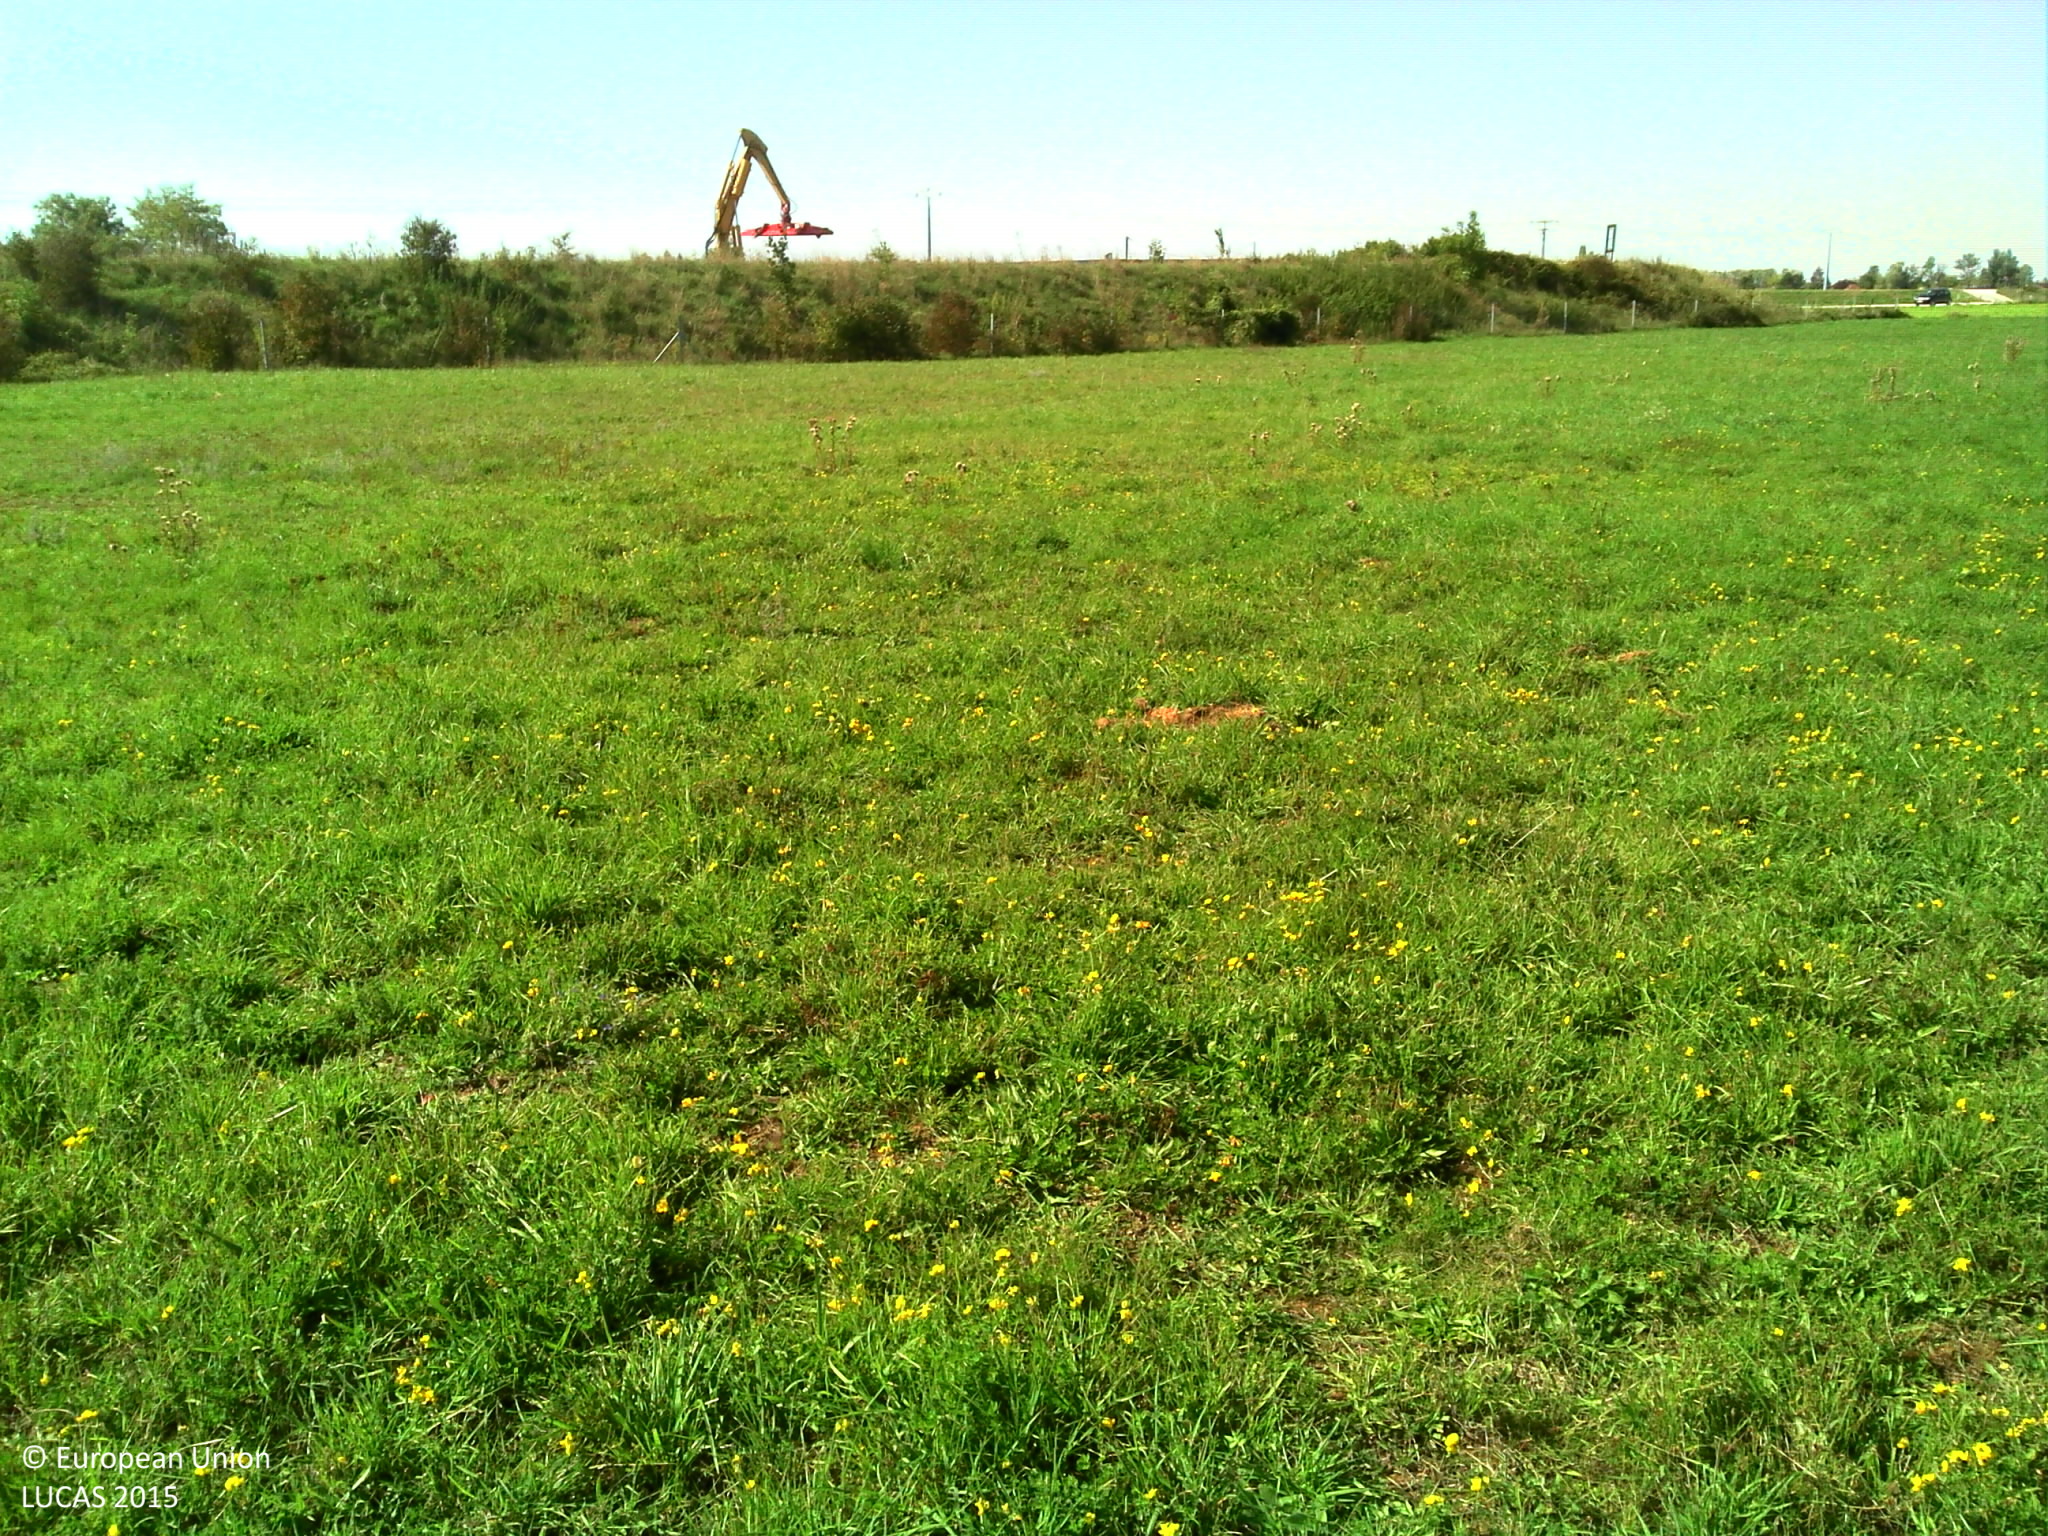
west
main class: Cropland
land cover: Temporary grasslands
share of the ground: > 75 %
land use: Agriculture (excluding fallow land and kitchen gardens)
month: September
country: FR
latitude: 48.1791
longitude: 4.2004
